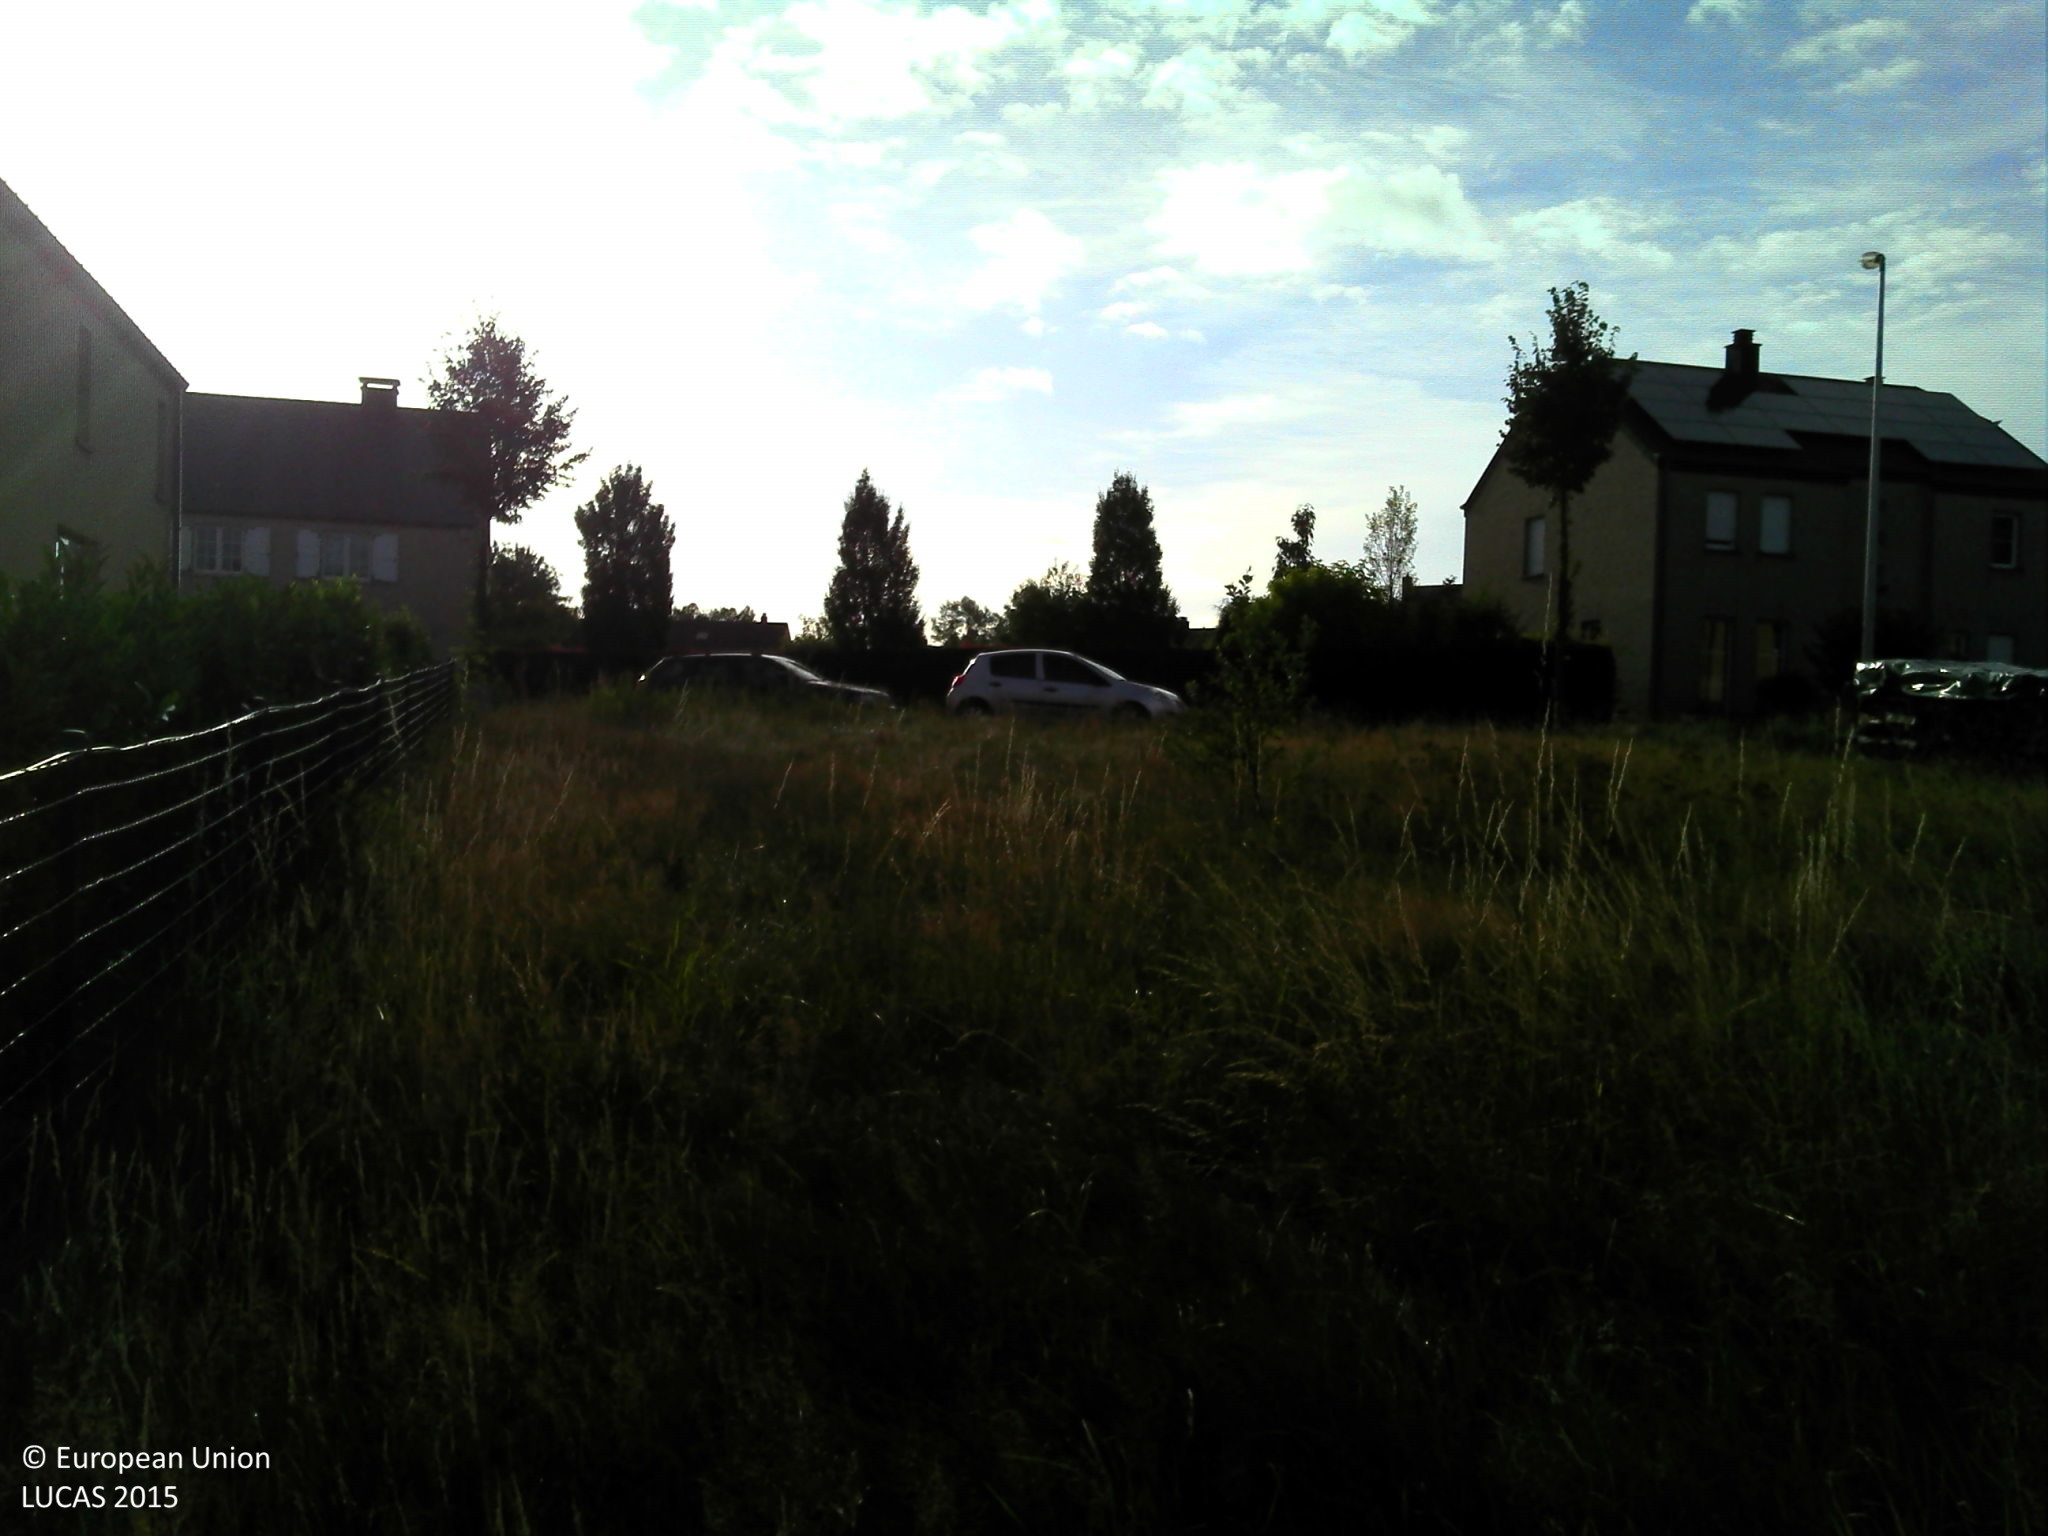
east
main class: Grassland
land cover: Grassland without tree/shrub cover
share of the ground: > 75 %
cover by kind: herbaceous plants 100 %
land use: Residential
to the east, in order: Grassland without tree/shrub cover; Artificial constructions in urban areas; Abandoned hedges; Tracks; Grass margins; Abandoned hedges; Common wheat
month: July
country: BE
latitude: 49.6927
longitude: 5.7985
